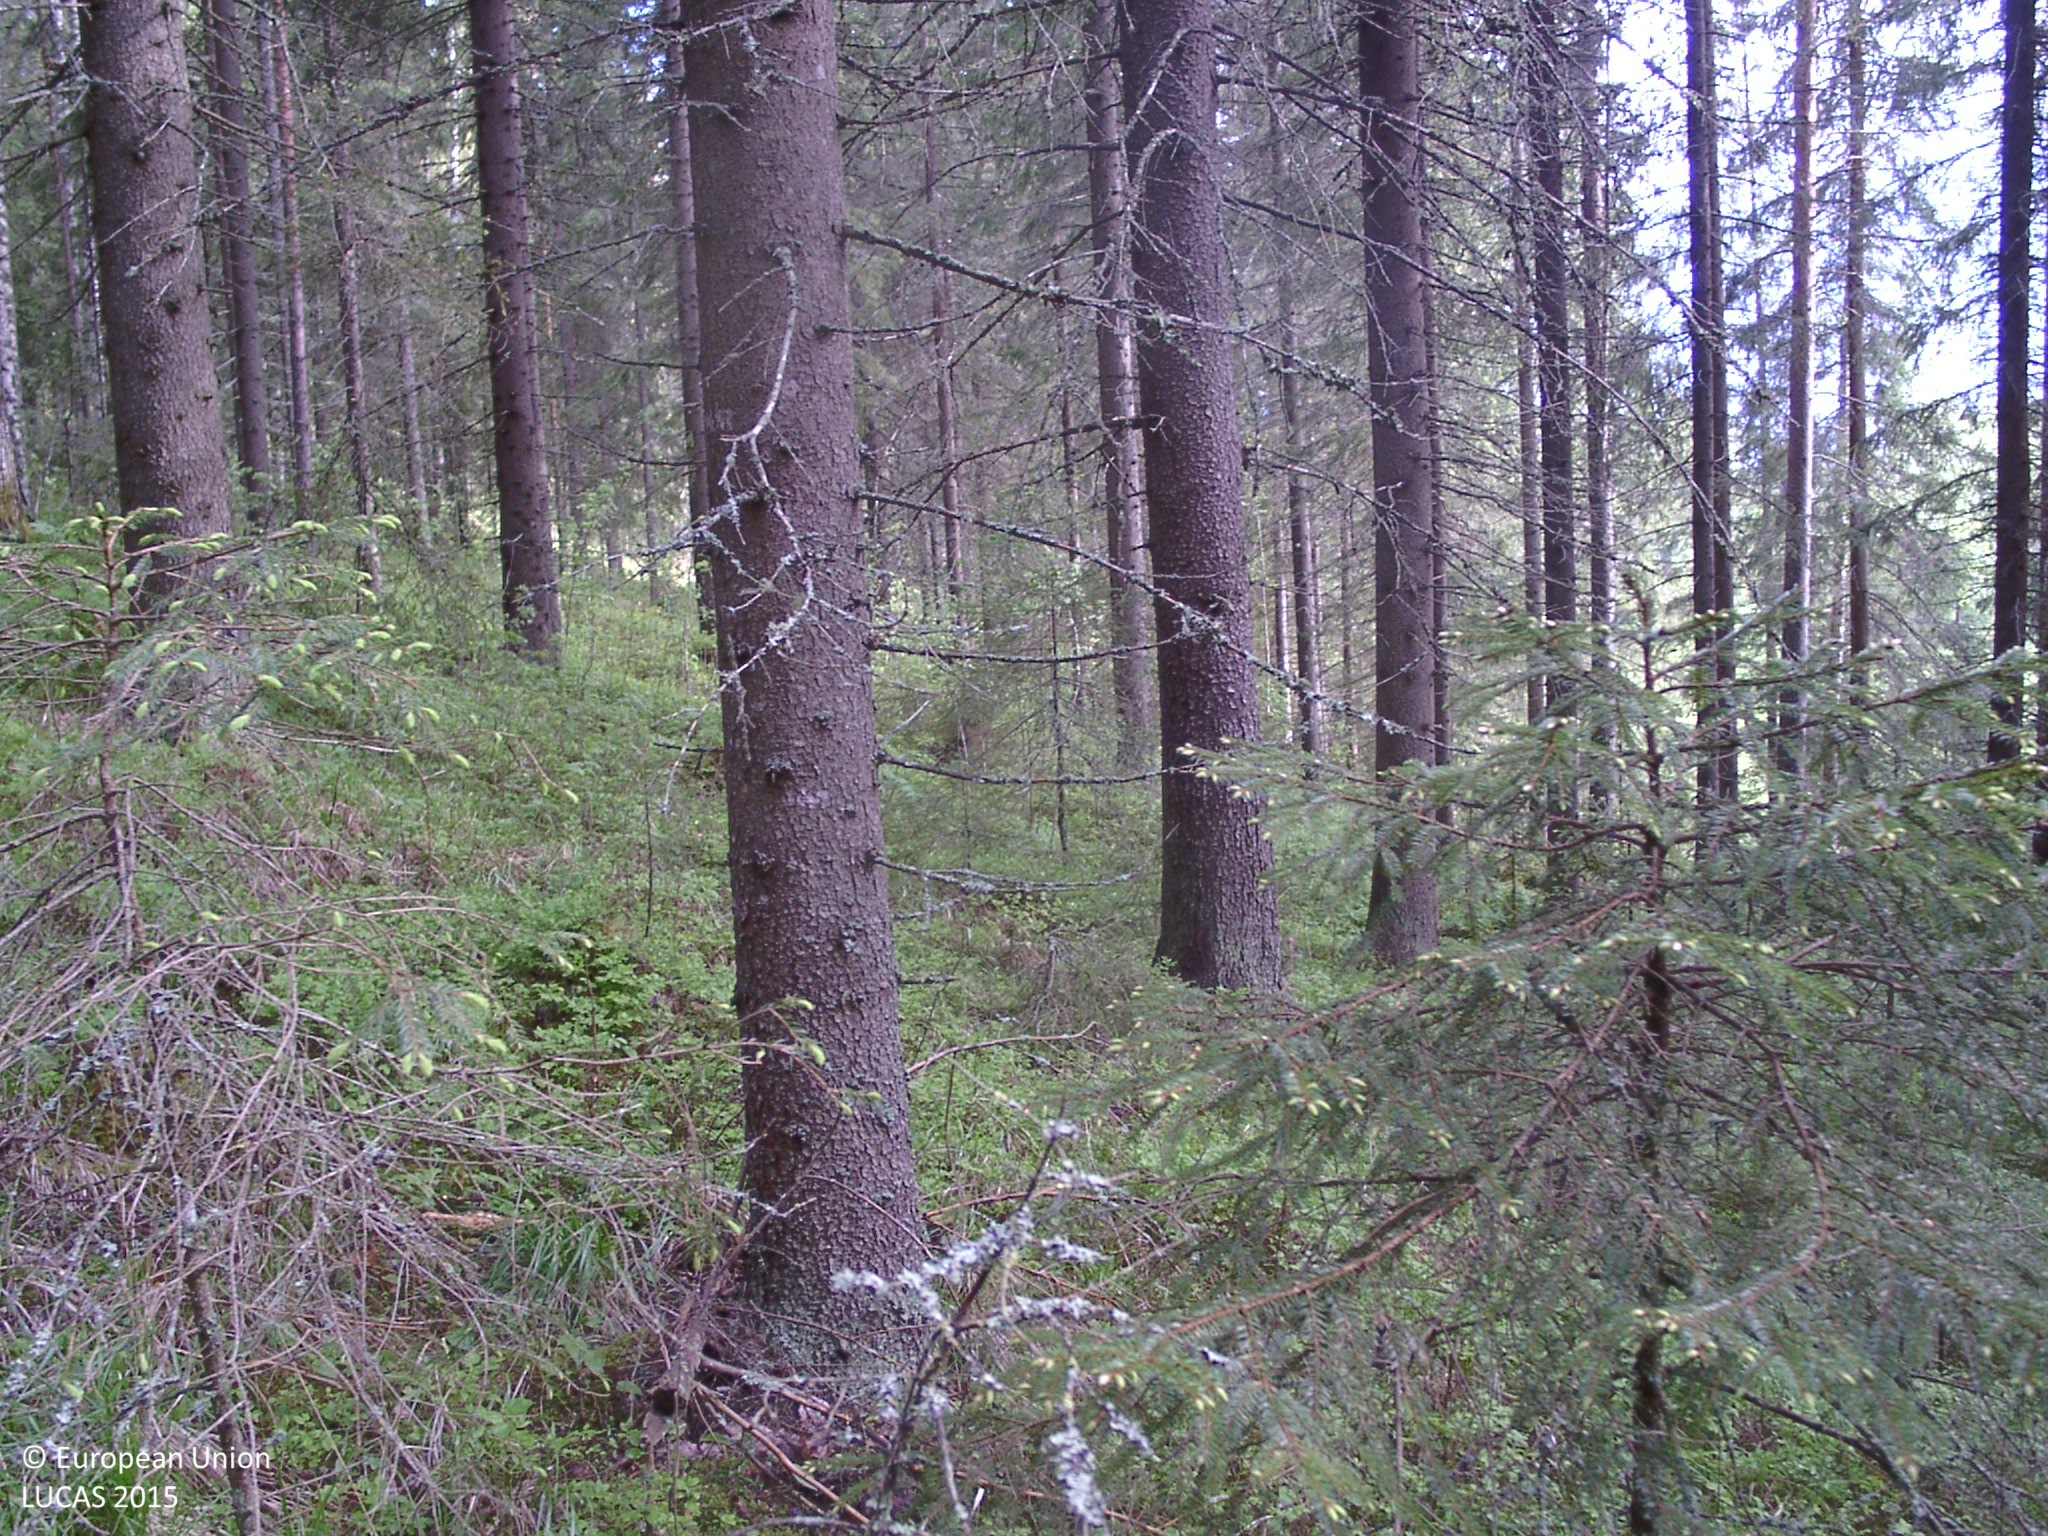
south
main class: Woodland
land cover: Spruce dominated coniferous woodland
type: boreal forest
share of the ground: 50 - 75 %
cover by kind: coniferous forest trees 65 %, shrubs 15 %, herbaceous plants 10 %, broadleaved forest trees 5 %, lichens and mosses 5 %
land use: Forestry
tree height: > 5 m
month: June
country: FI
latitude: 62.1891
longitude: 25.5045
